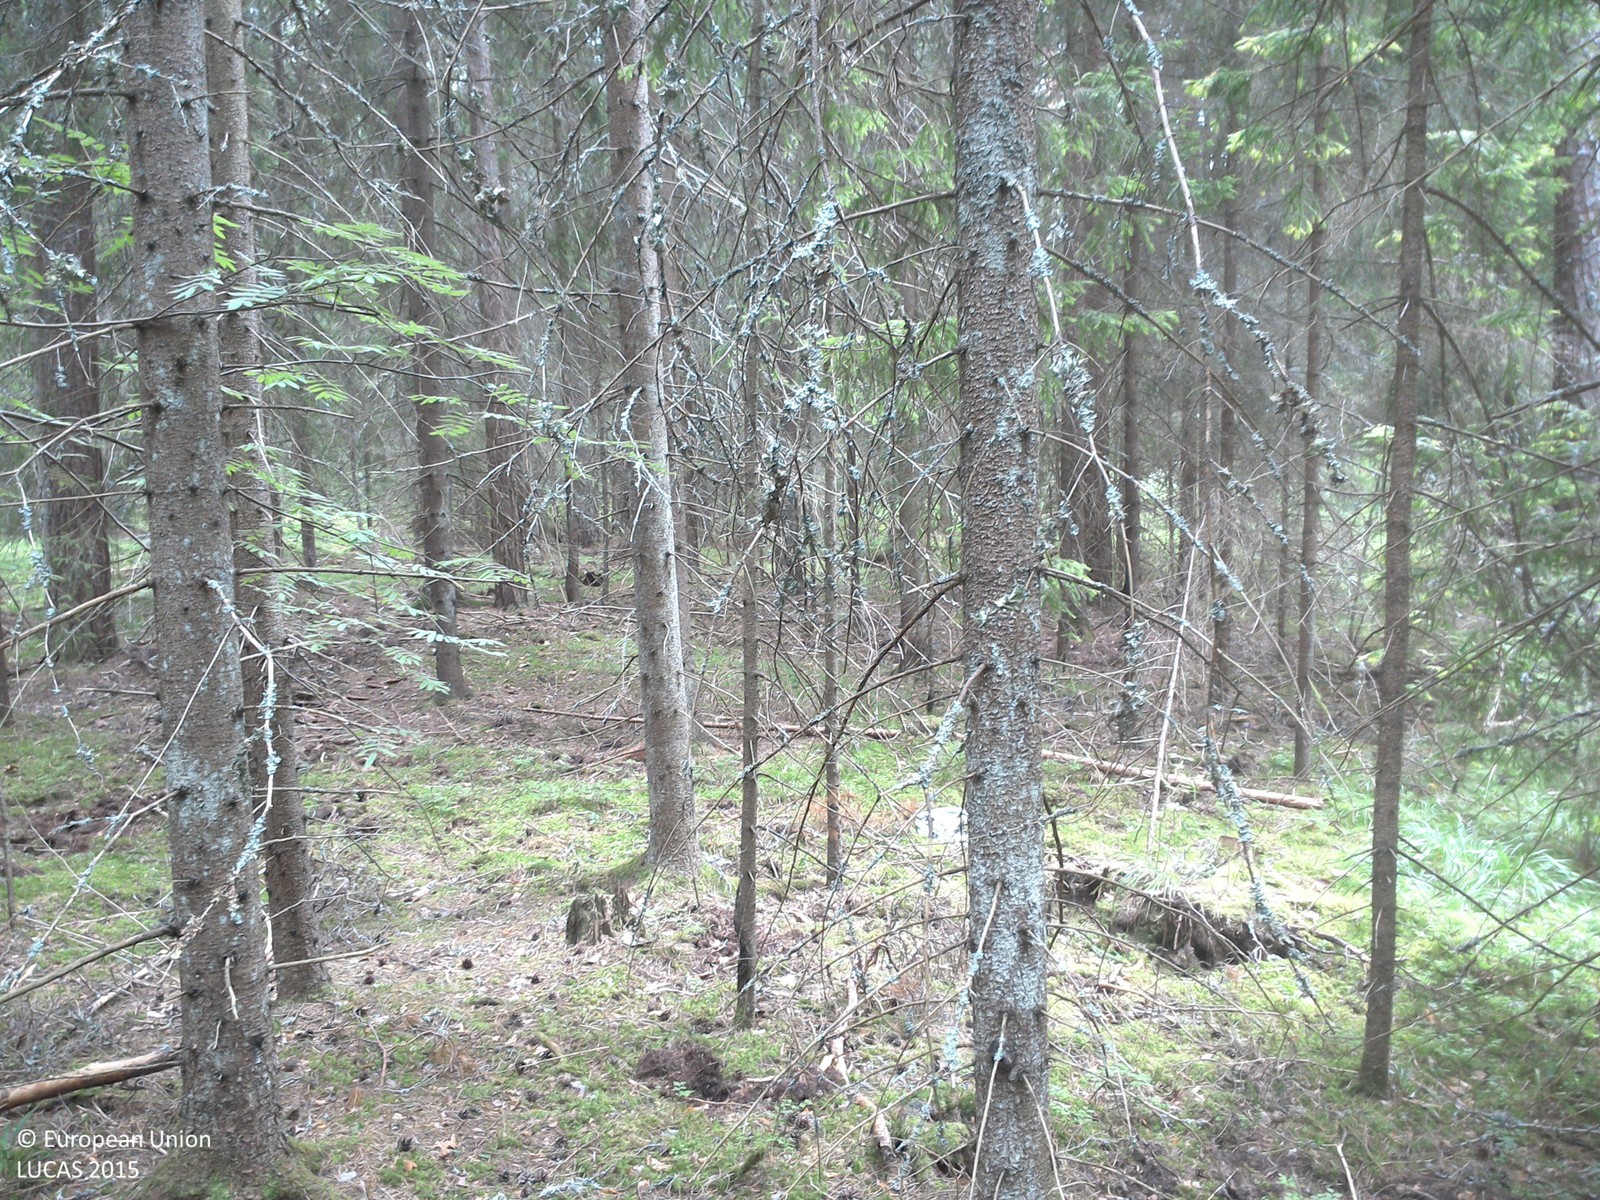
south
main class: Woodland
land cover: Spruce dominated coniferous woodland
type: boreal forest
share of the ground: 50 - 75 %
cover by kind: coniferous forest trees 60 %, herbaceous plants 20 %, lichens and mosses 20 %
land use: Forestry
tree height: > 5 m
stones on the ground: < 10 %
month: August
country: SE
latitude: 57.9811
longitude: 15.4914
